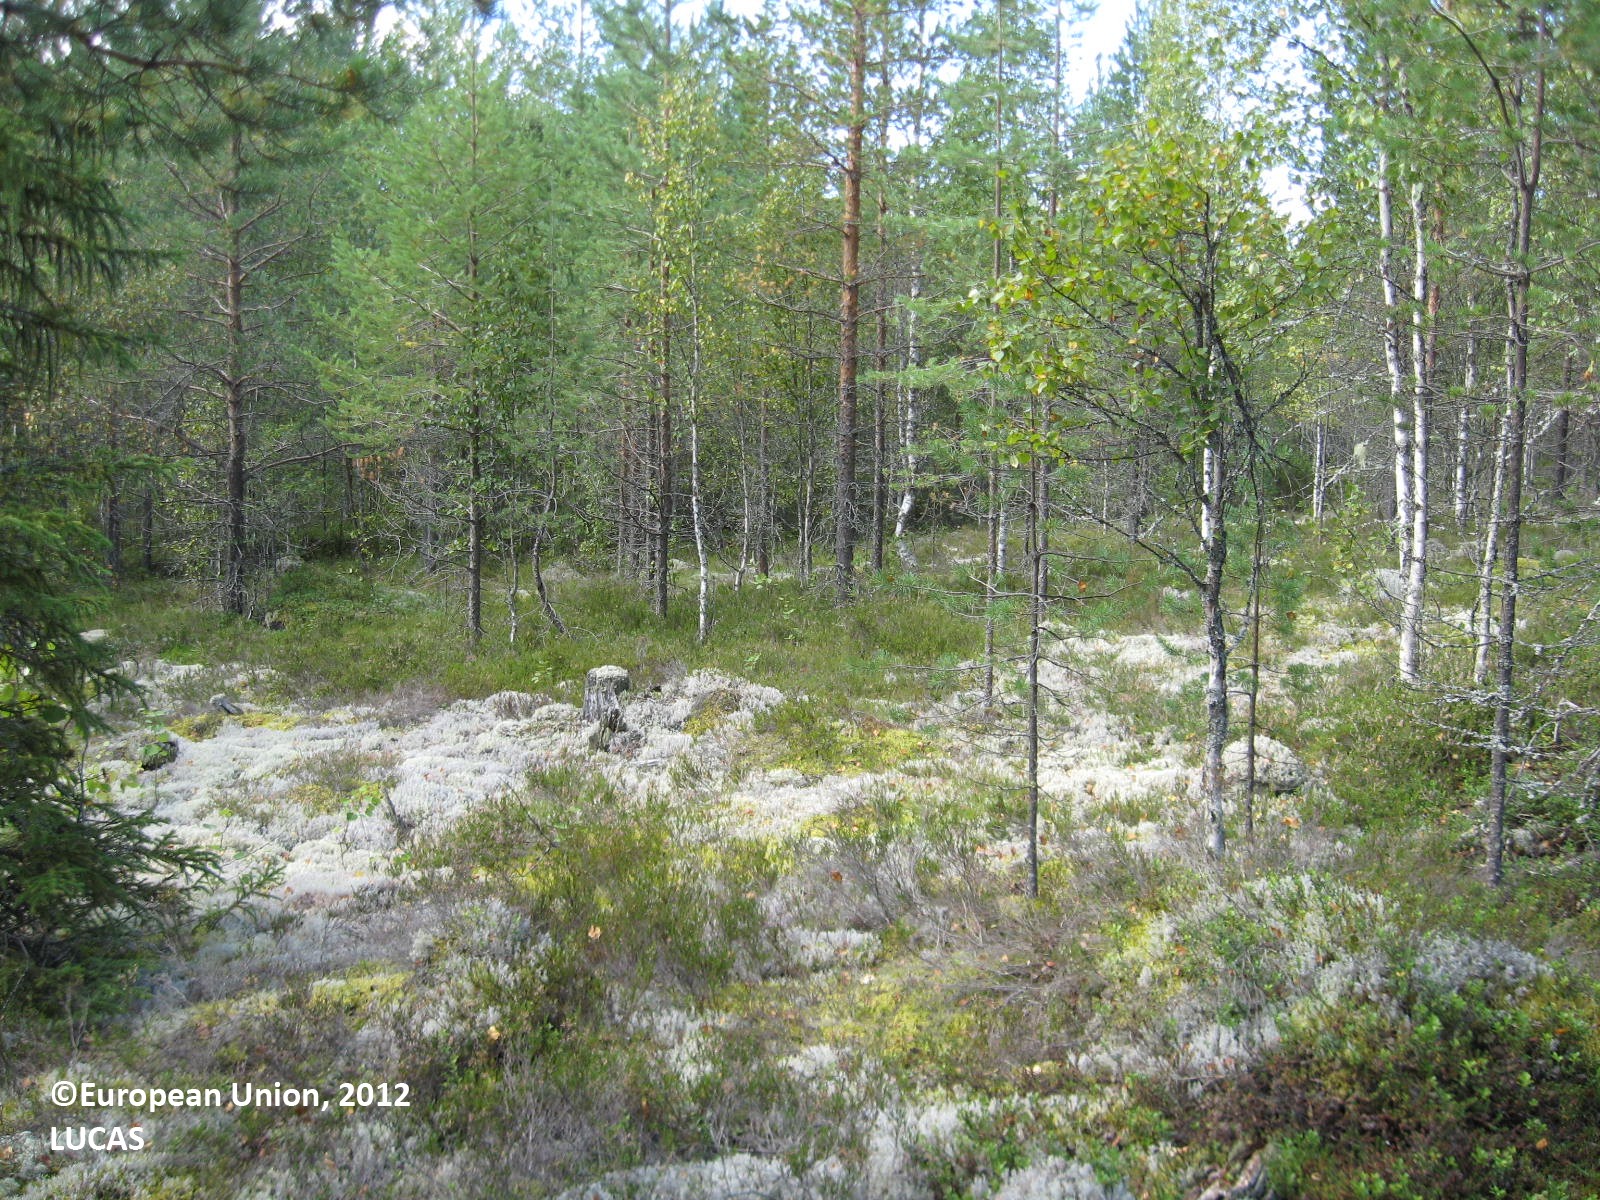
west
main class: Artificial land
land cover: Non built-up linear features
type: boreal forest
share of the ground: > 75 %
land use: Road transport
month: August
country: FI
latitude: 63.6202
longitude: 29.9108
